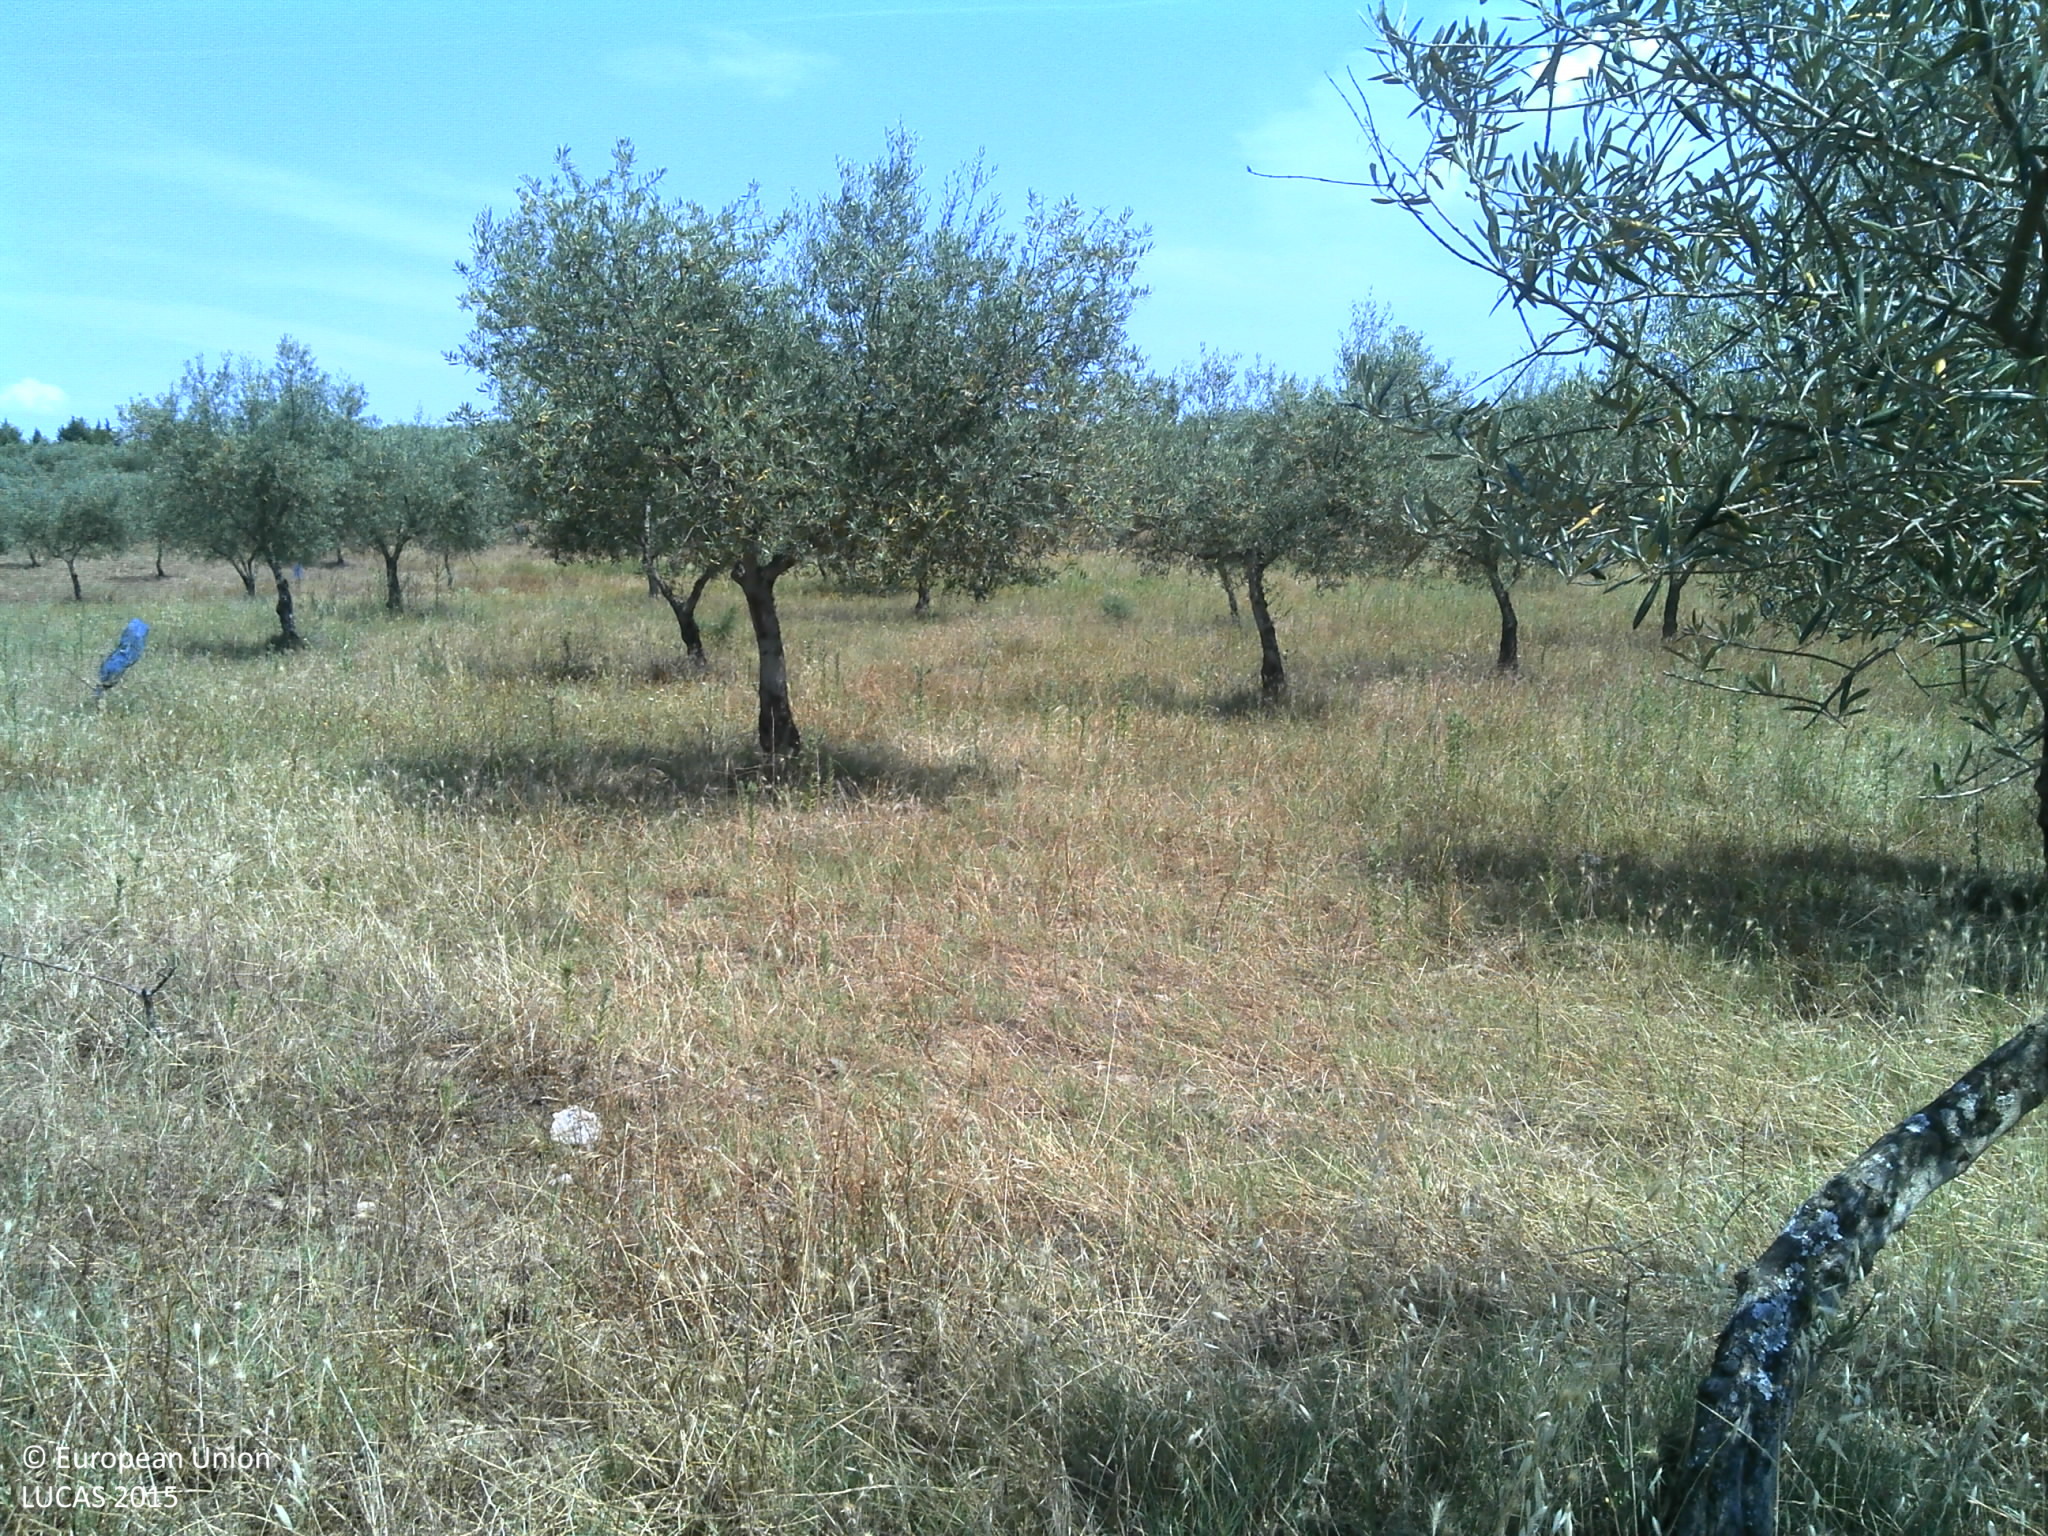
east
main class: Cropland
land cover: Olive groves
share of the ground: < 10 %
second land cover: Spontaneously vegetated surfaces
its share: 25 - 50 %
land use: Agriculture (excluding fallow land and kitchen gardens)
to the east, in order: Olive groves; Spontaneously vegetated surfaces; Olive groves; Shrubland without tree cover; Grassland without tree/shrub cover
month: June
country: PT
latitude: 41.5151
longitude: -7.1206
